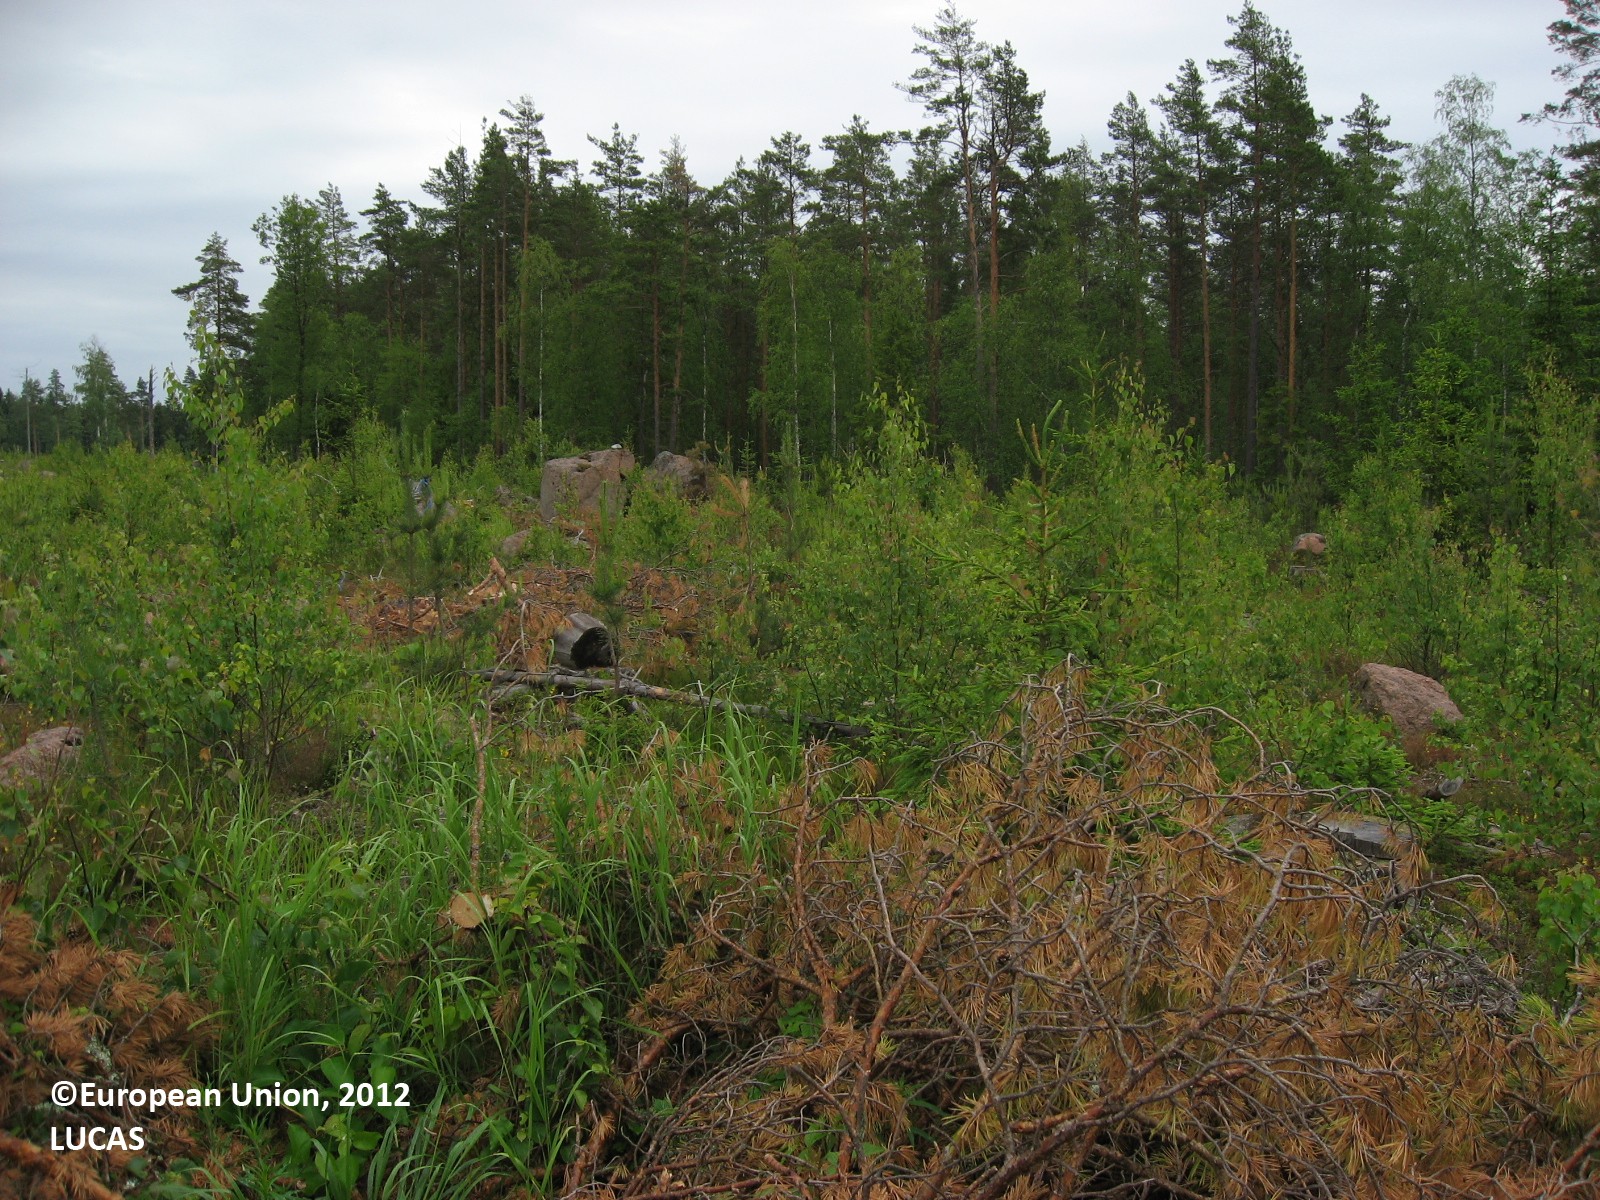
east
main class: Woodland
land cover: Pine dominated mixed woodland
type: boreal forest
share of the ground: 10 - 25 %
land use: Forestry
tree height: < 5 m
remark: Clear cut
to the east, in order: Pine dominated mixed woodland; Spruce dominated coniferous woodland
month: June
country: FI
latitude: 60.4219
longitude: 26.2968
